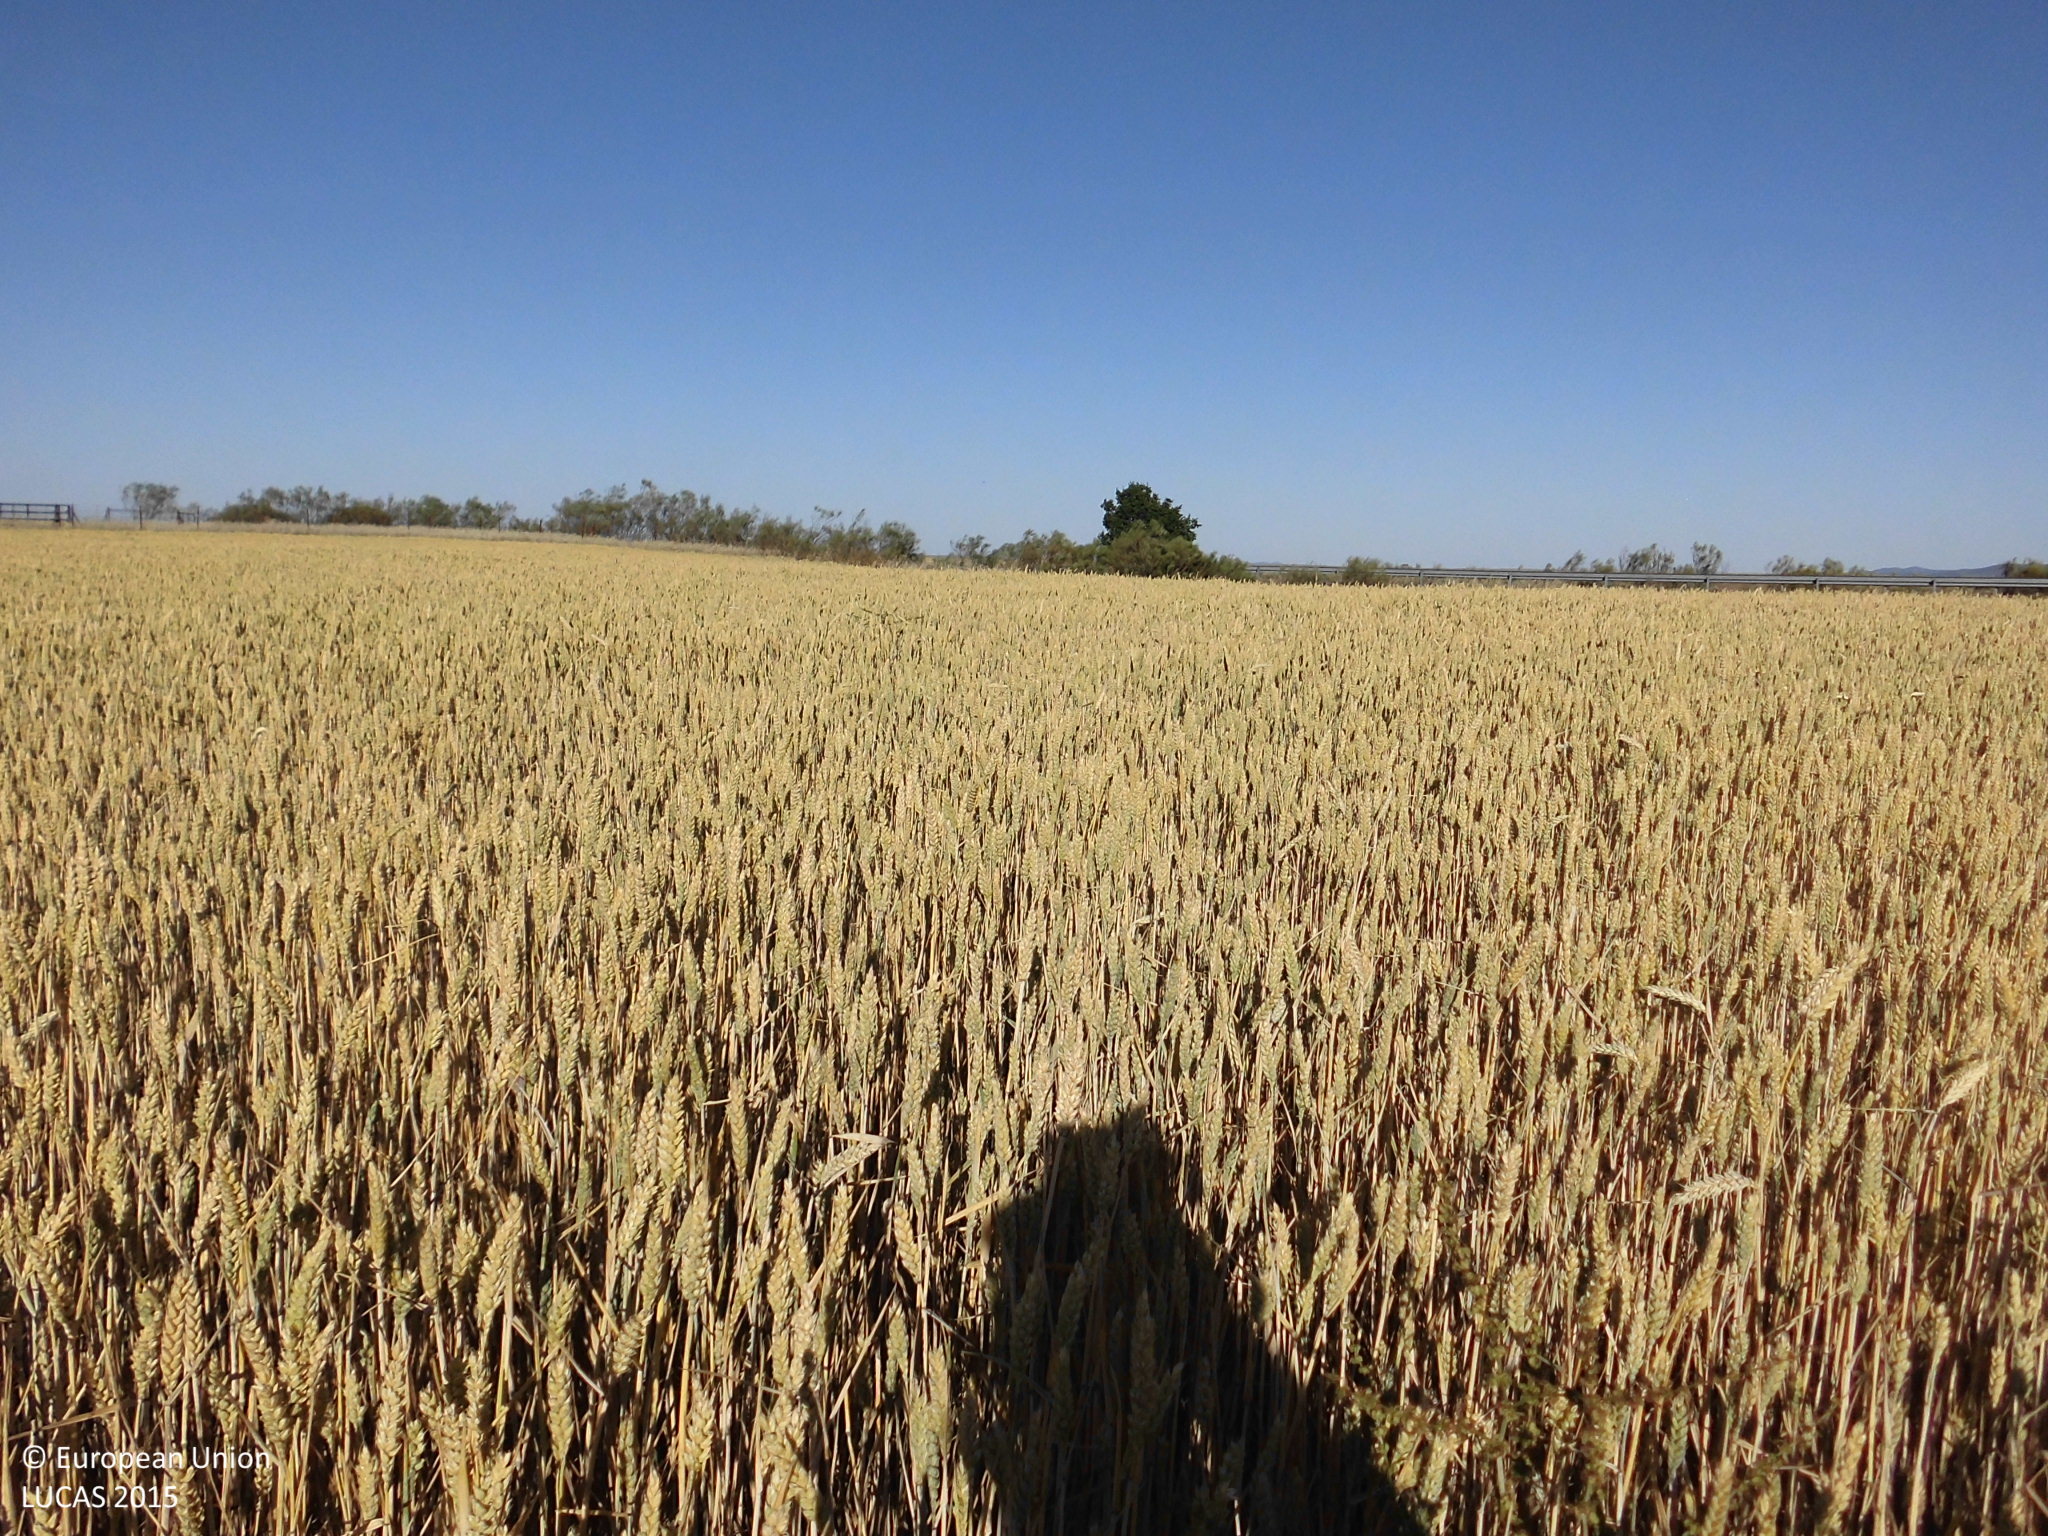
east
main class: Cropland
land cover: Common wheat
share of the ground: > 75 %
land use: Agriculture (excluding fallow land and kitchen gardens)
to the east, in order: Common wheat; Fences; Grass margins; Paved roads, cycling and walking lanes; Shruby margins; Fences; Grassland without tree/shrub cover
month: May
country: ES
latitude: 39.5148
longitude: -6.8631
